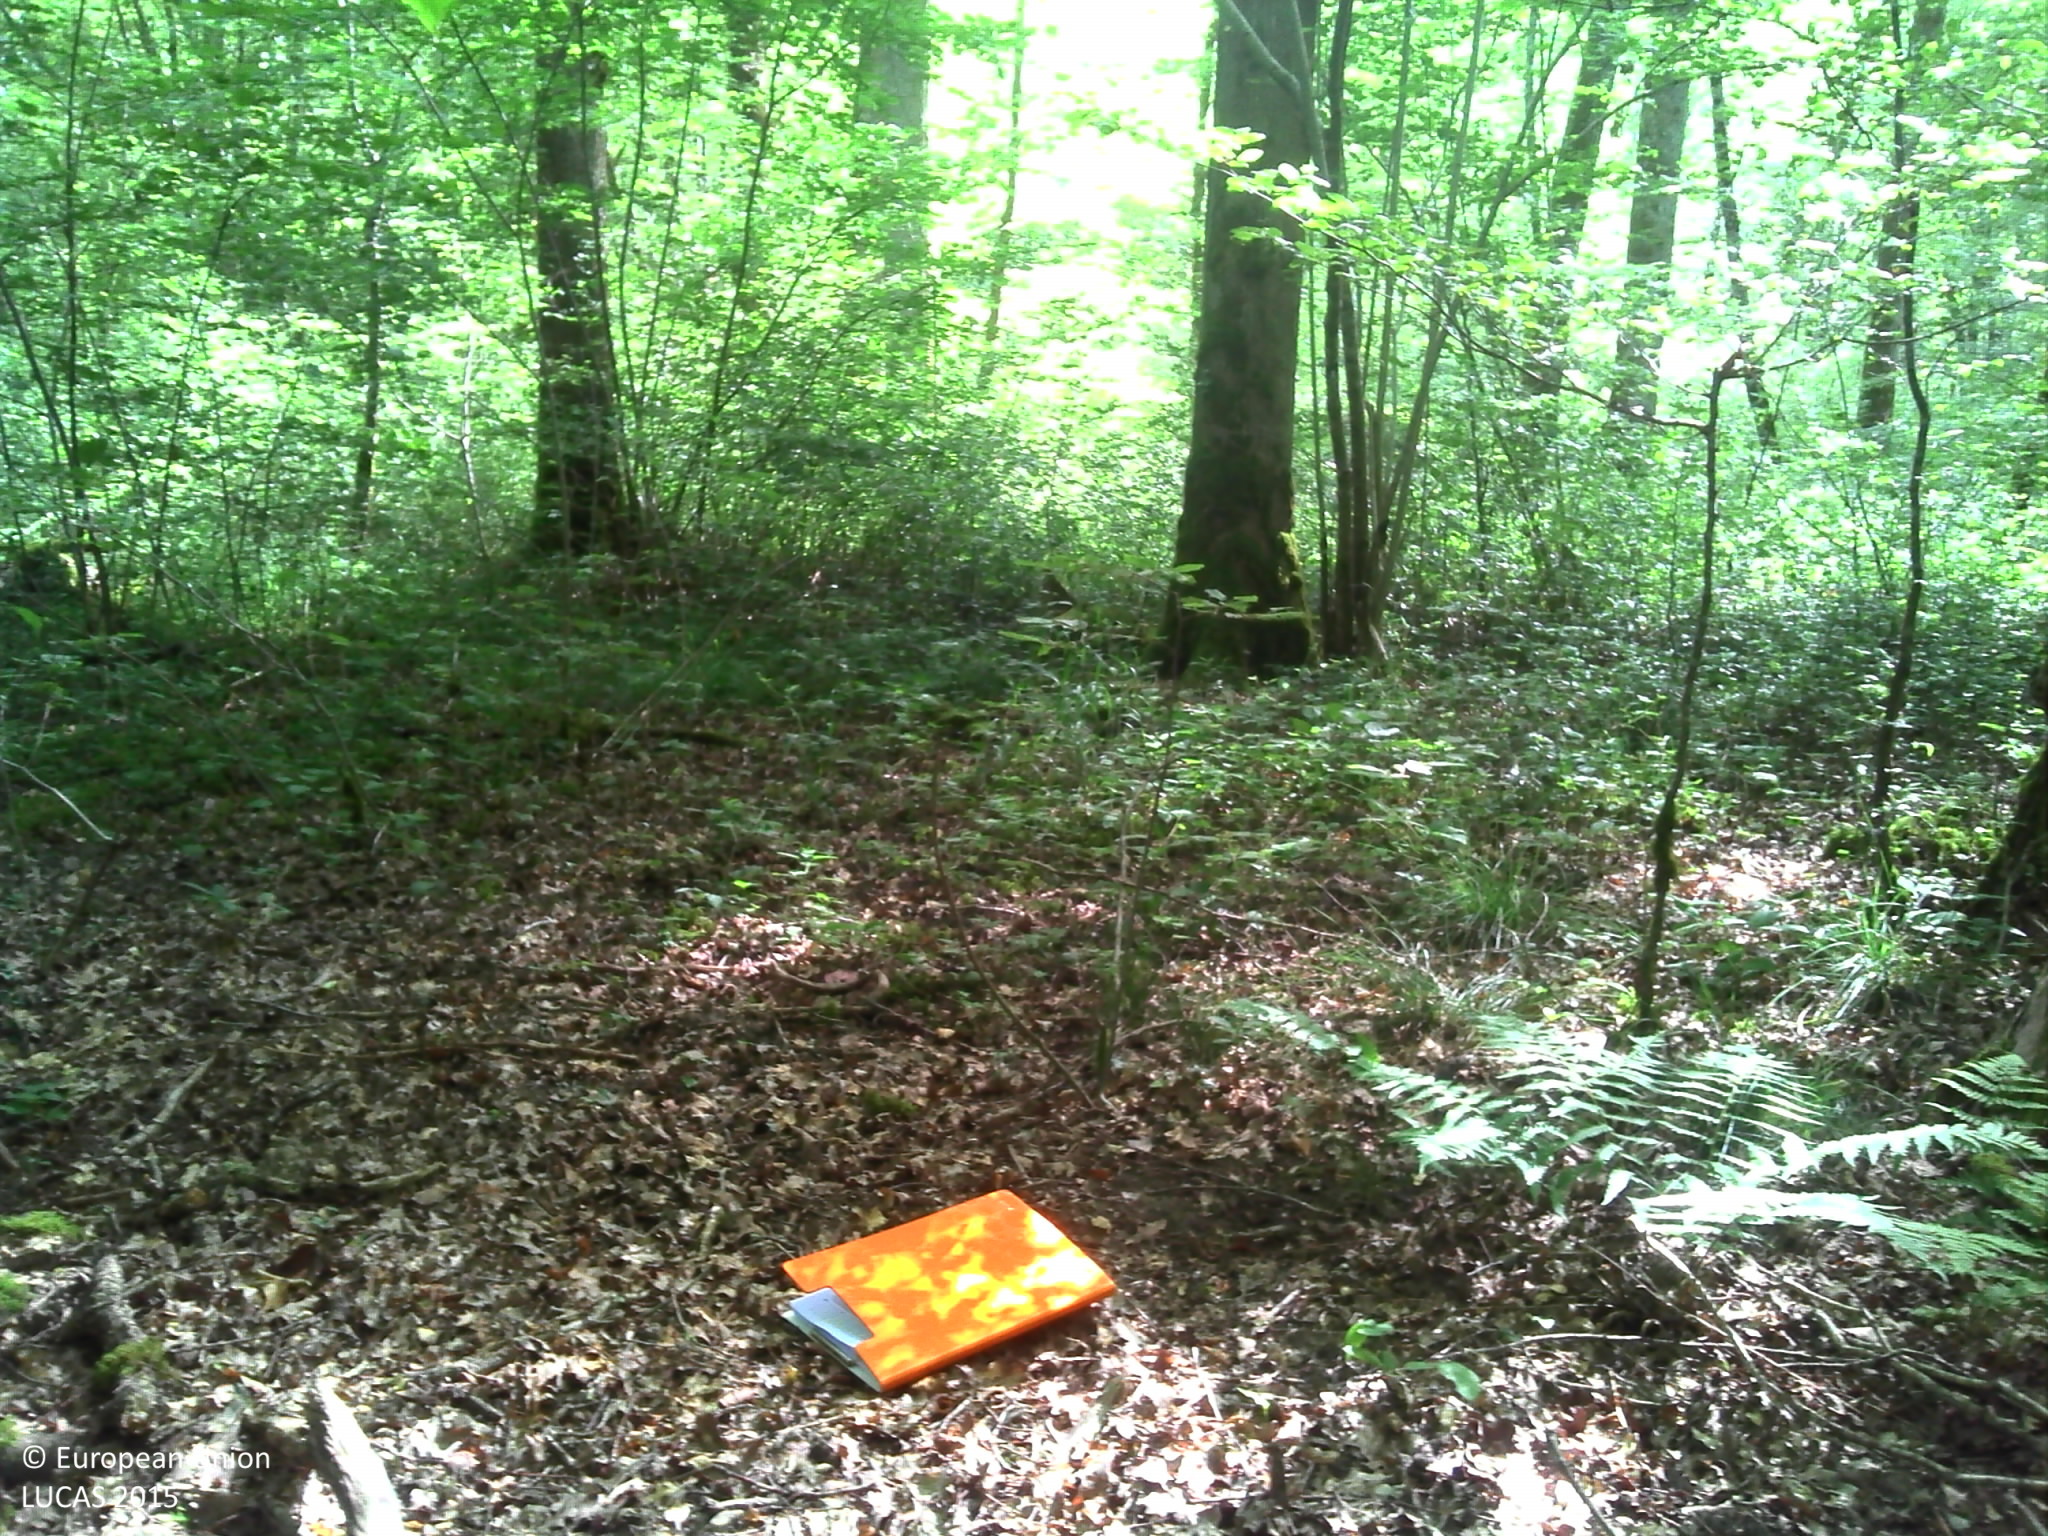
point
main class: Woodland
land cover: Broadleaved woodland
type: mesophytic deciduous forest
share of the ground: > 75 %
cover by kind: broadleaved forest trees 95 %, herbaceous plants 5 %
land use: Forestry
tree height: > 5 m
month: June
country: FR
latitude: 46.8989
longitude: 2.9996
